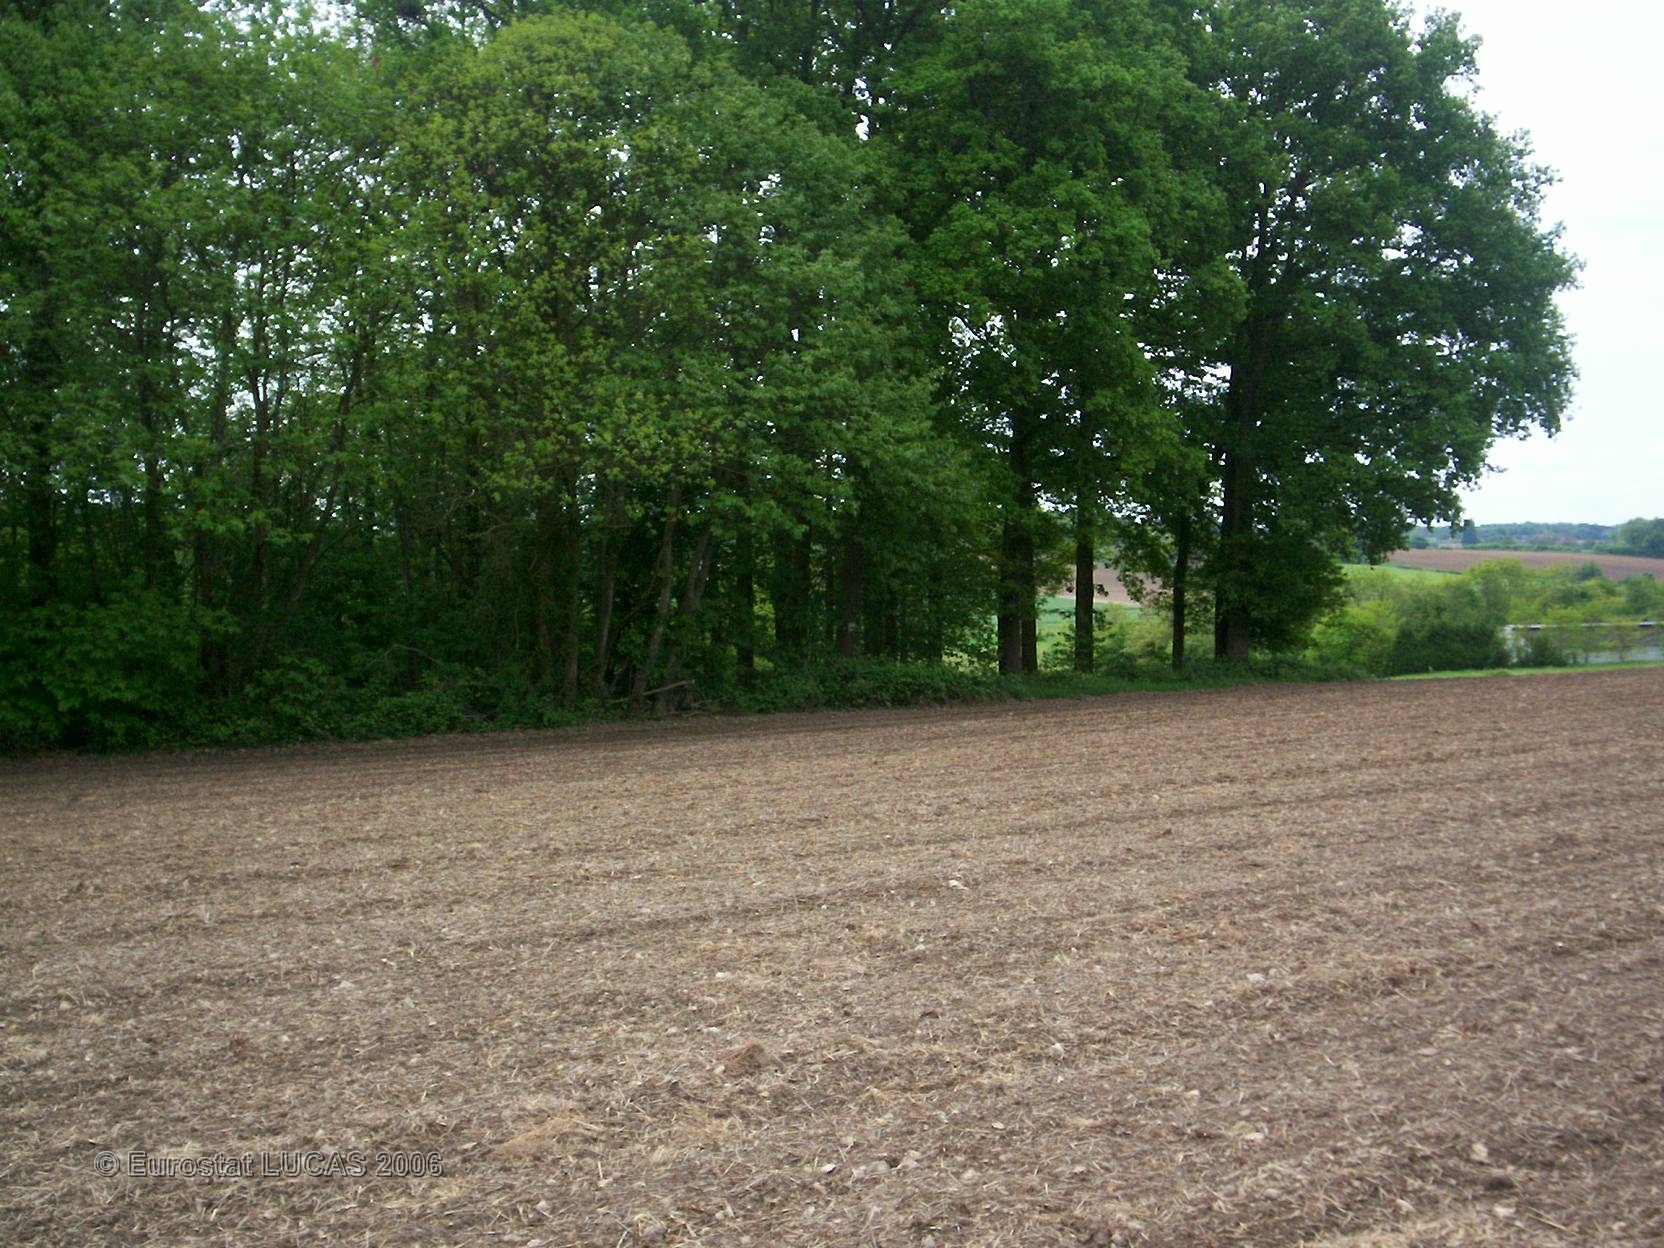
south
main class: Cropland
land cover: Sunflower
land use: Agriculture (excluding fallow land and kitchen gardens)
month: May
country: FR
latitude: 47.8005
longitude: 0.1611
